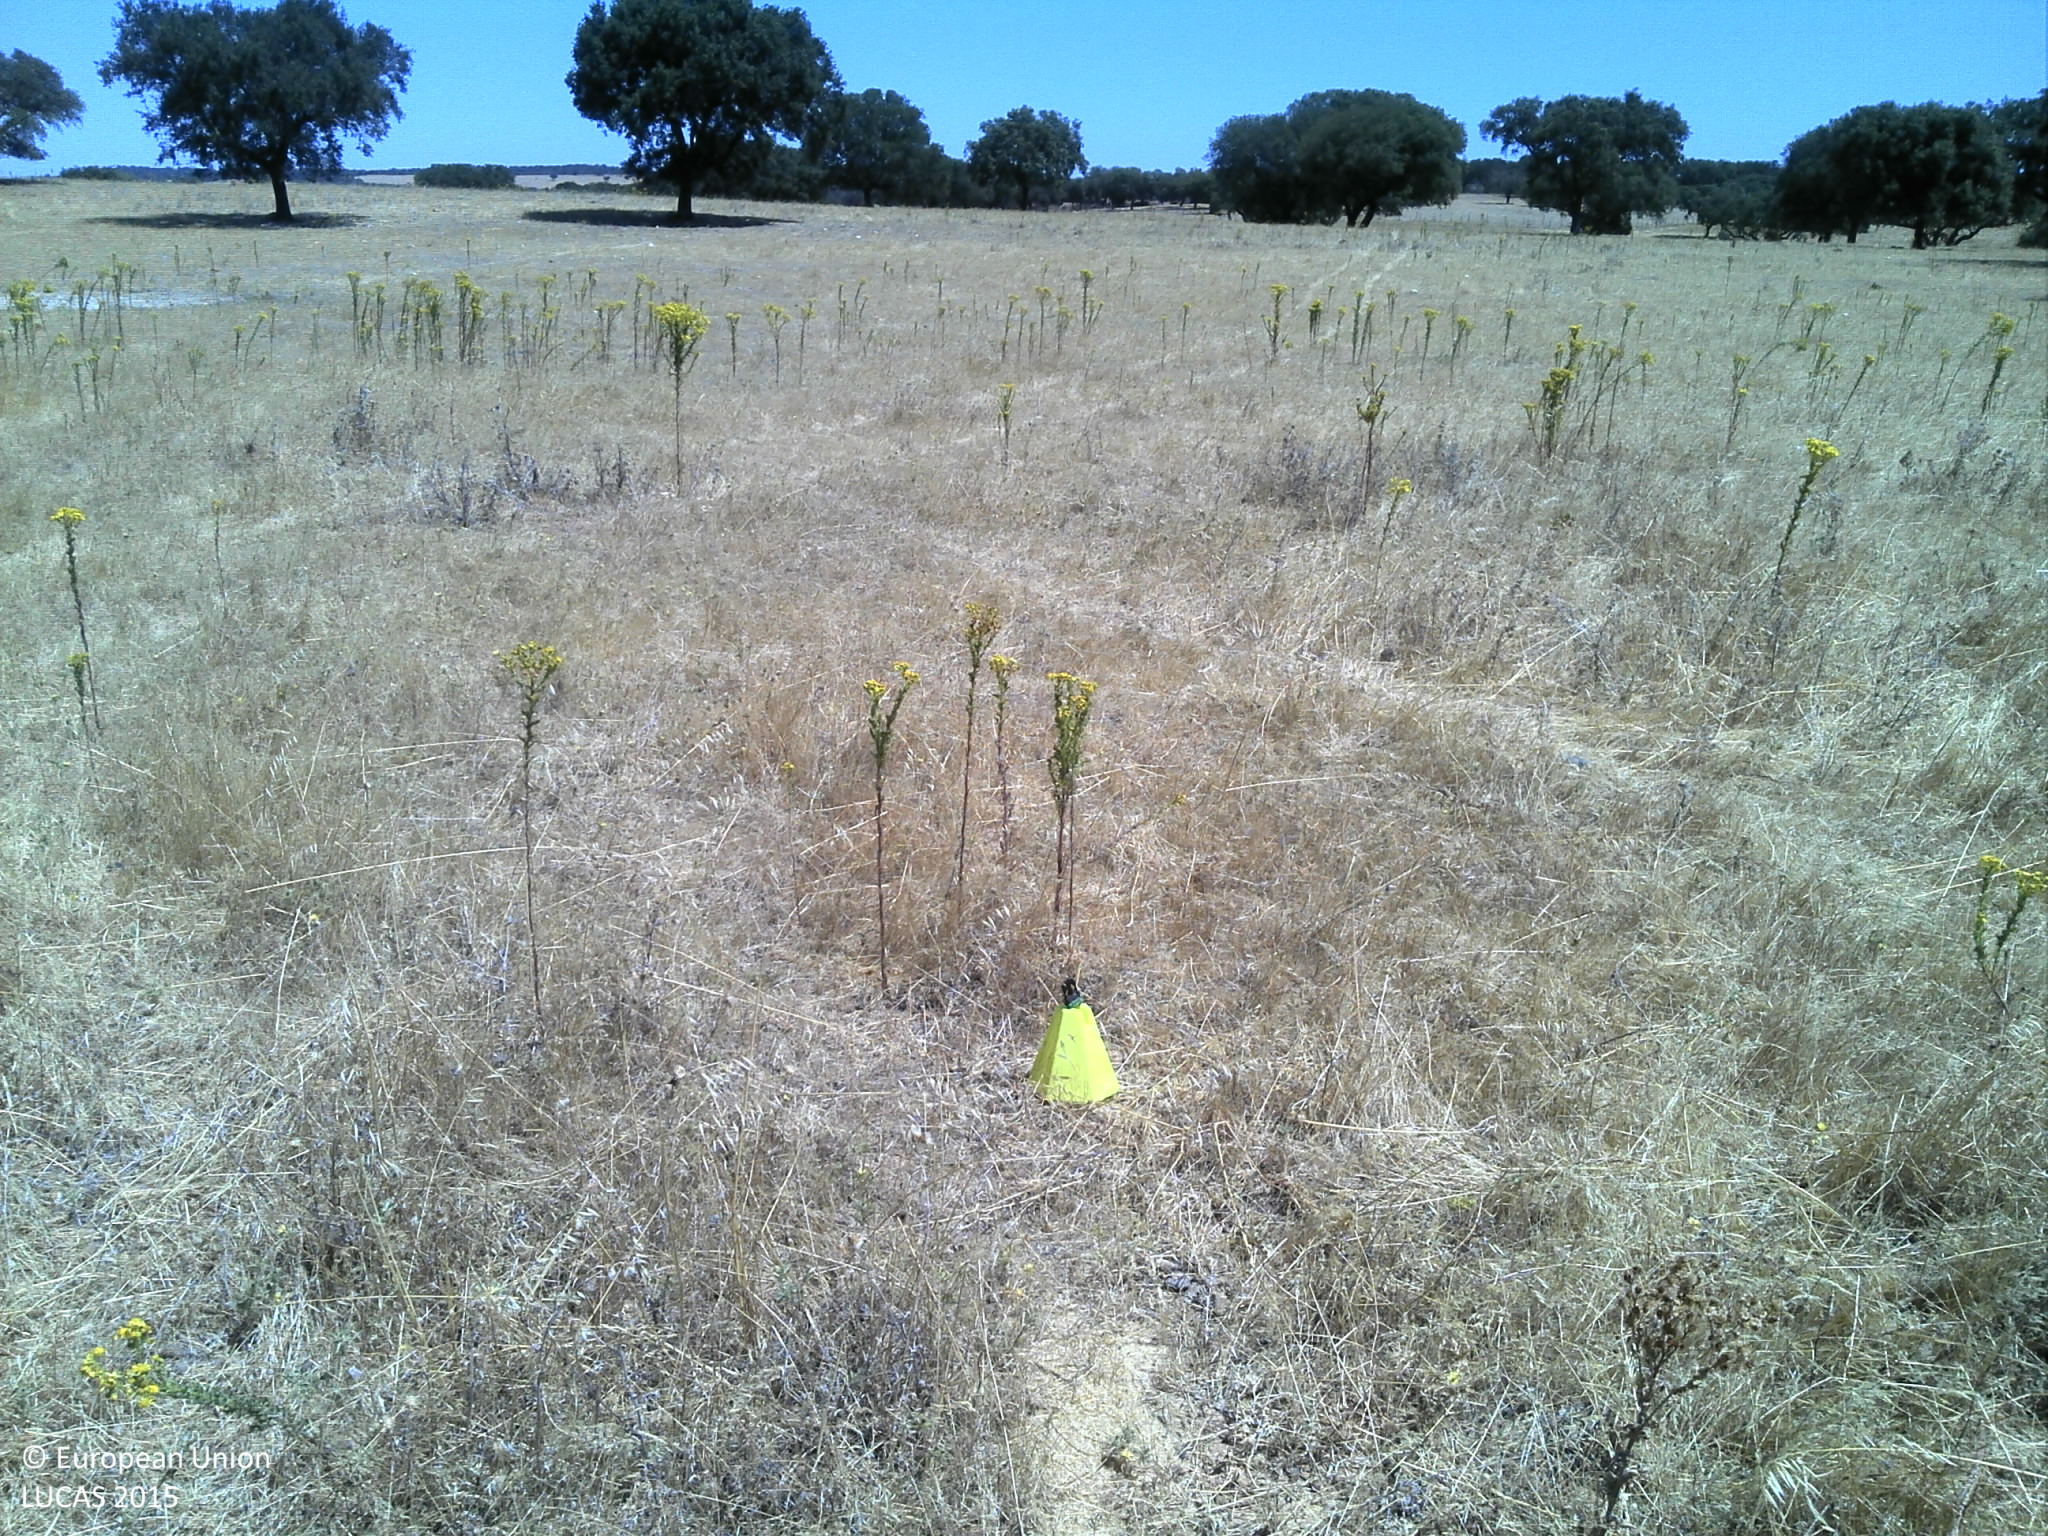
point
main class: Grassland
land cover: Grassland without tree/shrub cover
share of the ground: 25 - 50 %
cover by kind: unconsolidated bare surface 70 %, herbaceous plants 30 %
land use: Agriculture (excluding fallow land and kitchen gardens)
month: July
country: PT
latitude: 38.8784
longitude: -7.4281
